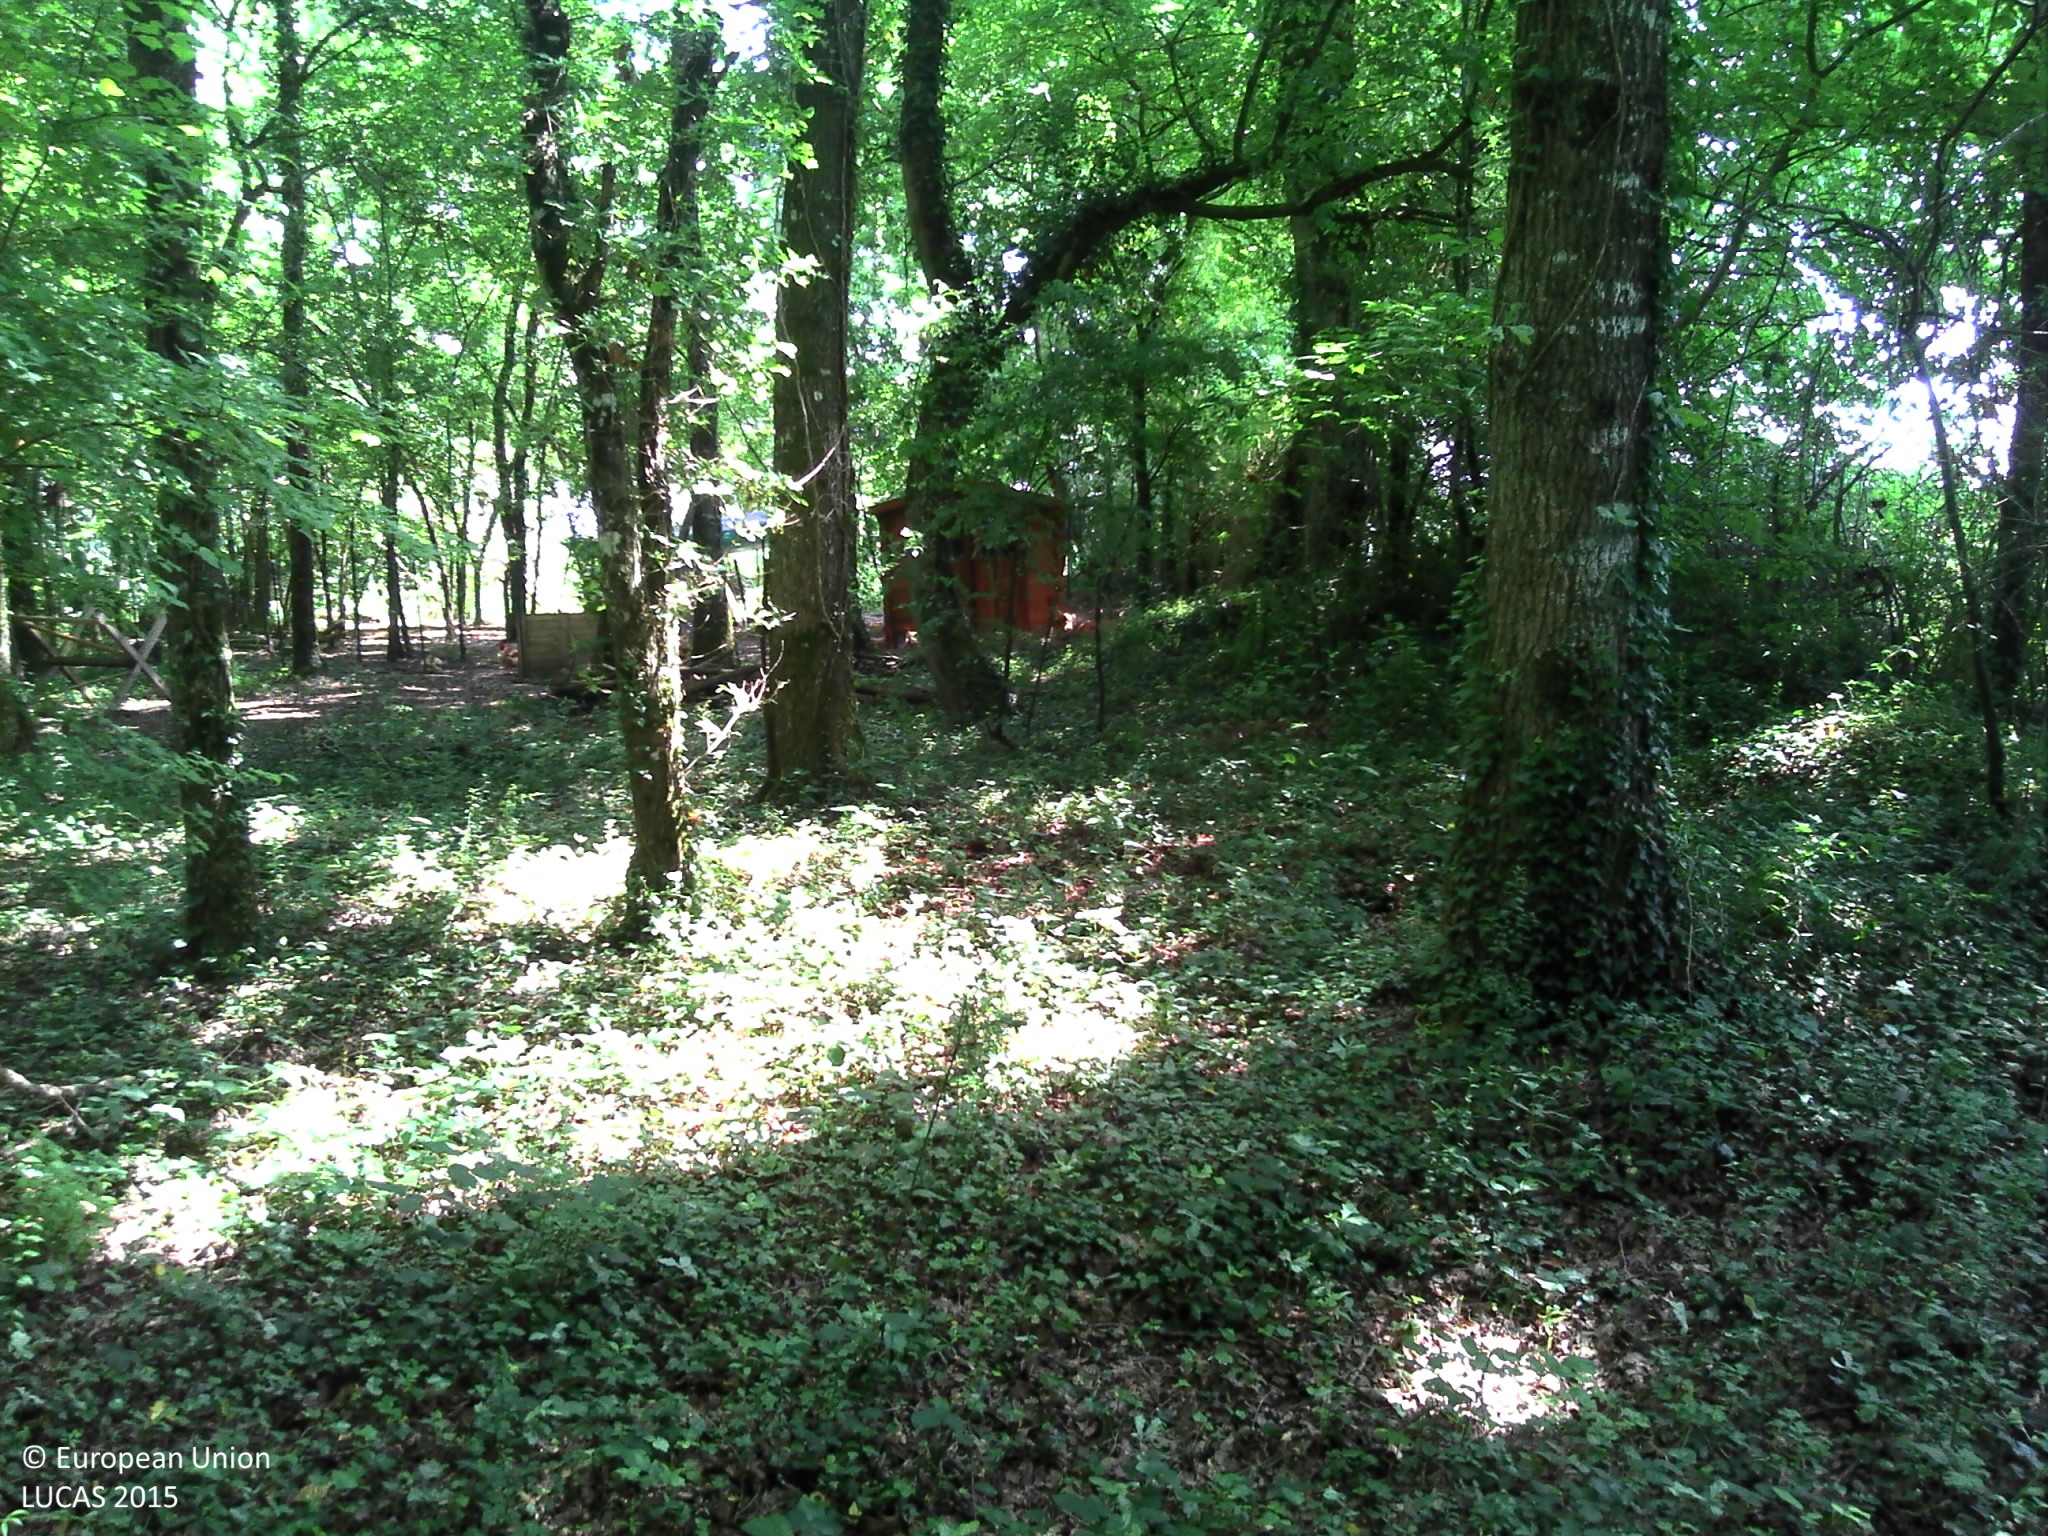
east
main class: Woodland
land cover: Broadleaved woodland
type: mesophytic deciduous forest
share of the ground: > 75 %
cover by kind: broadleaved forest trees 95 %, herbaceous plants 5 %
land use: Forestry
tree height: > 5 m
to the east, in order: Broadleaved woodland; Artificial constructions in urban areas; Broadleaved woodland; Grass margins; Ditches and canals; Grass margins; Paved roads, cycling and walking lanes; Grass margins; Ditches and canals; Grass margins; Barley
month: June
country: FR
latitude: 46.5395
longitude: 0.4500
